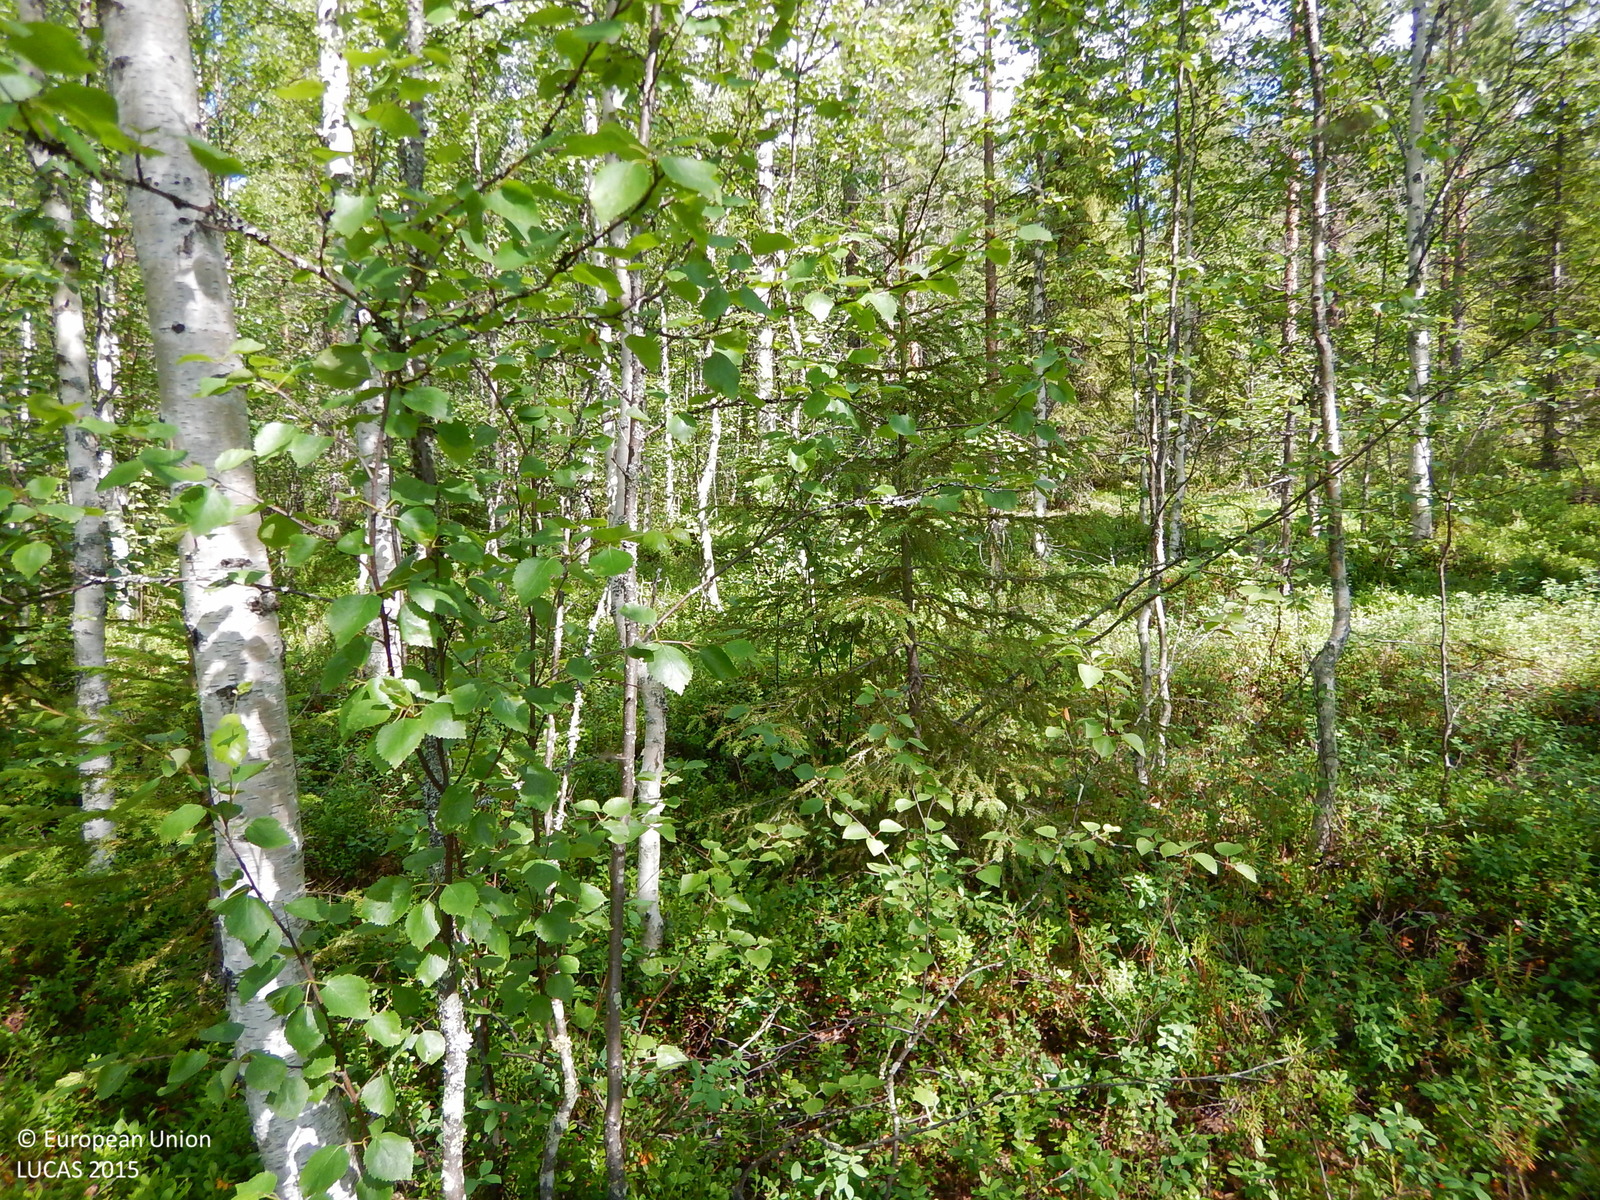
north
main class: Woodland
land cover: Broadleaved woodland
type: boreal forest
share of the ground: 25 - 50 %
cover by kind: broadleaved forest trees 45 %, shrubs 30 %, herbaceous plants 10 %, lichens and mosses 10 %, coniferous forest trees 5 %
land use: Forestry
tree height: > 5 m
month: July
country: SE
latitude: 65.0142
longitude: 19.9627
